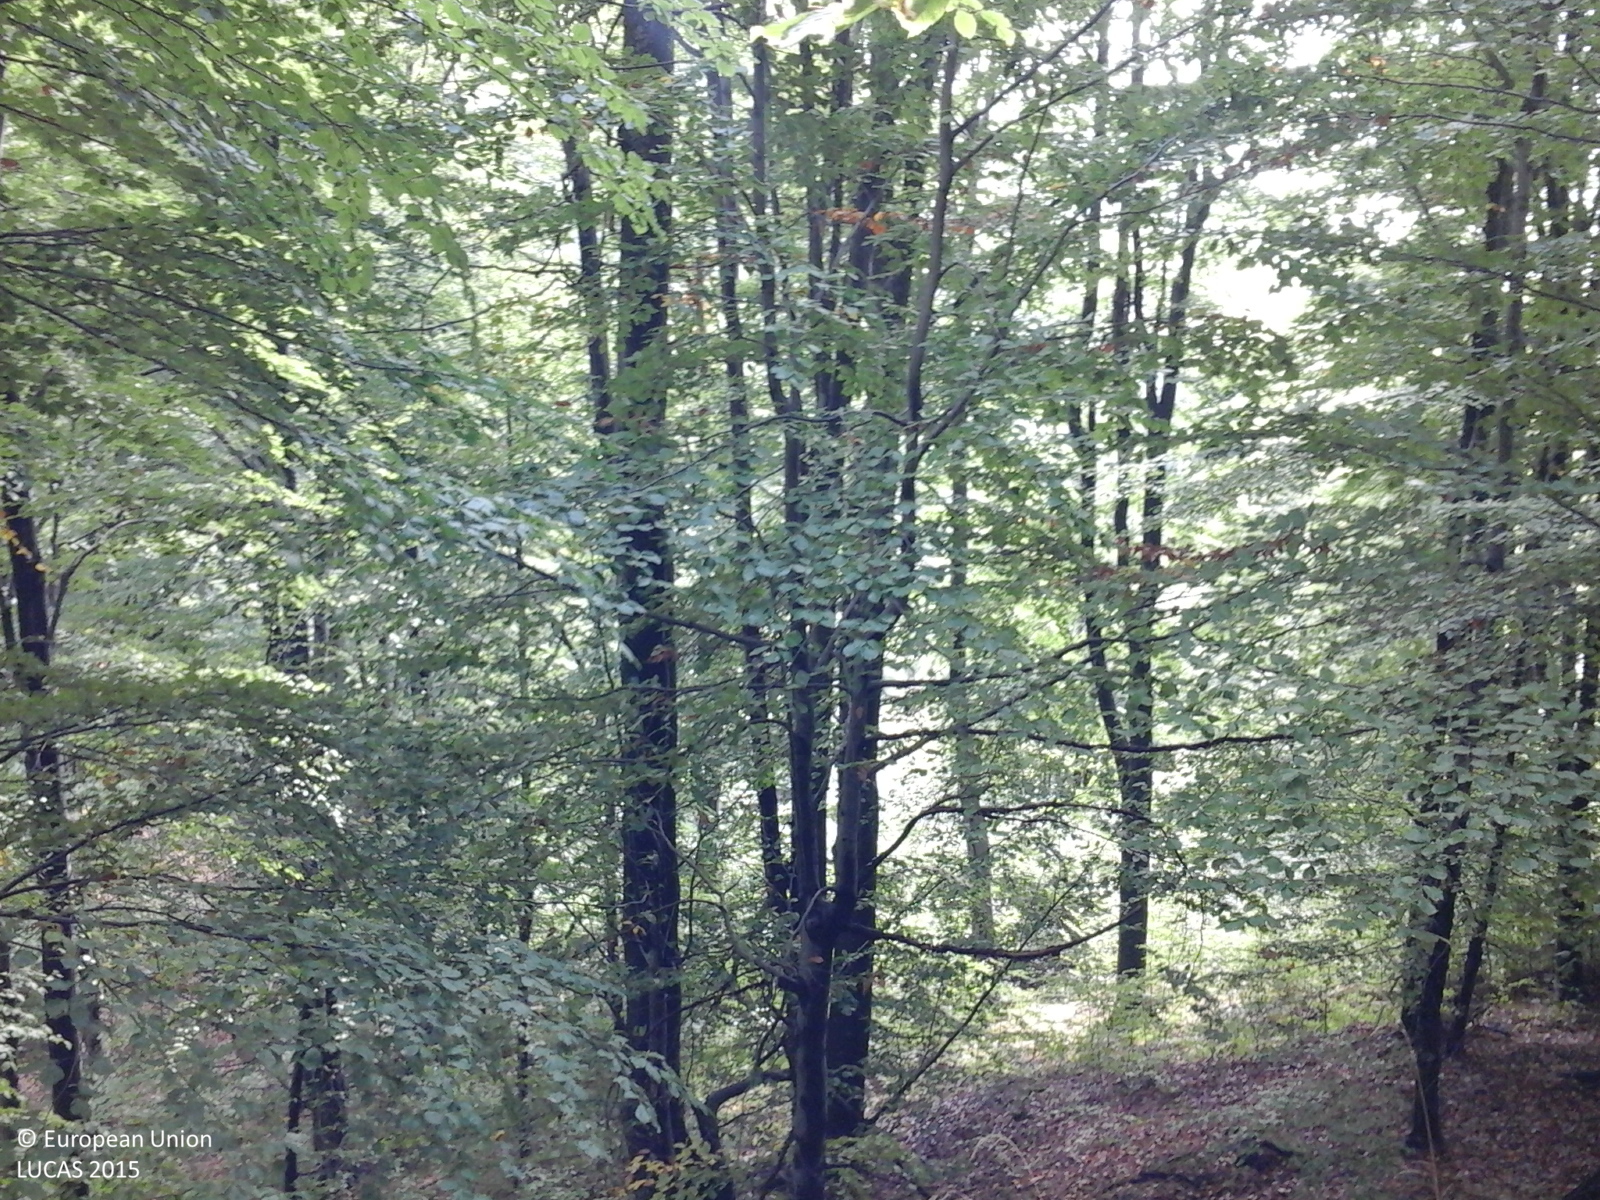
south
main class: Woodland
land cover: Broadleaved woodland
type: beech forest
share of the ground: > 75 %
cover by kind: broadleaved forest trees 100 %
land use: Forestry
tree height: > 5 m
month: September
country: RO
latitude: 45.2612
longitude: 23.2968
